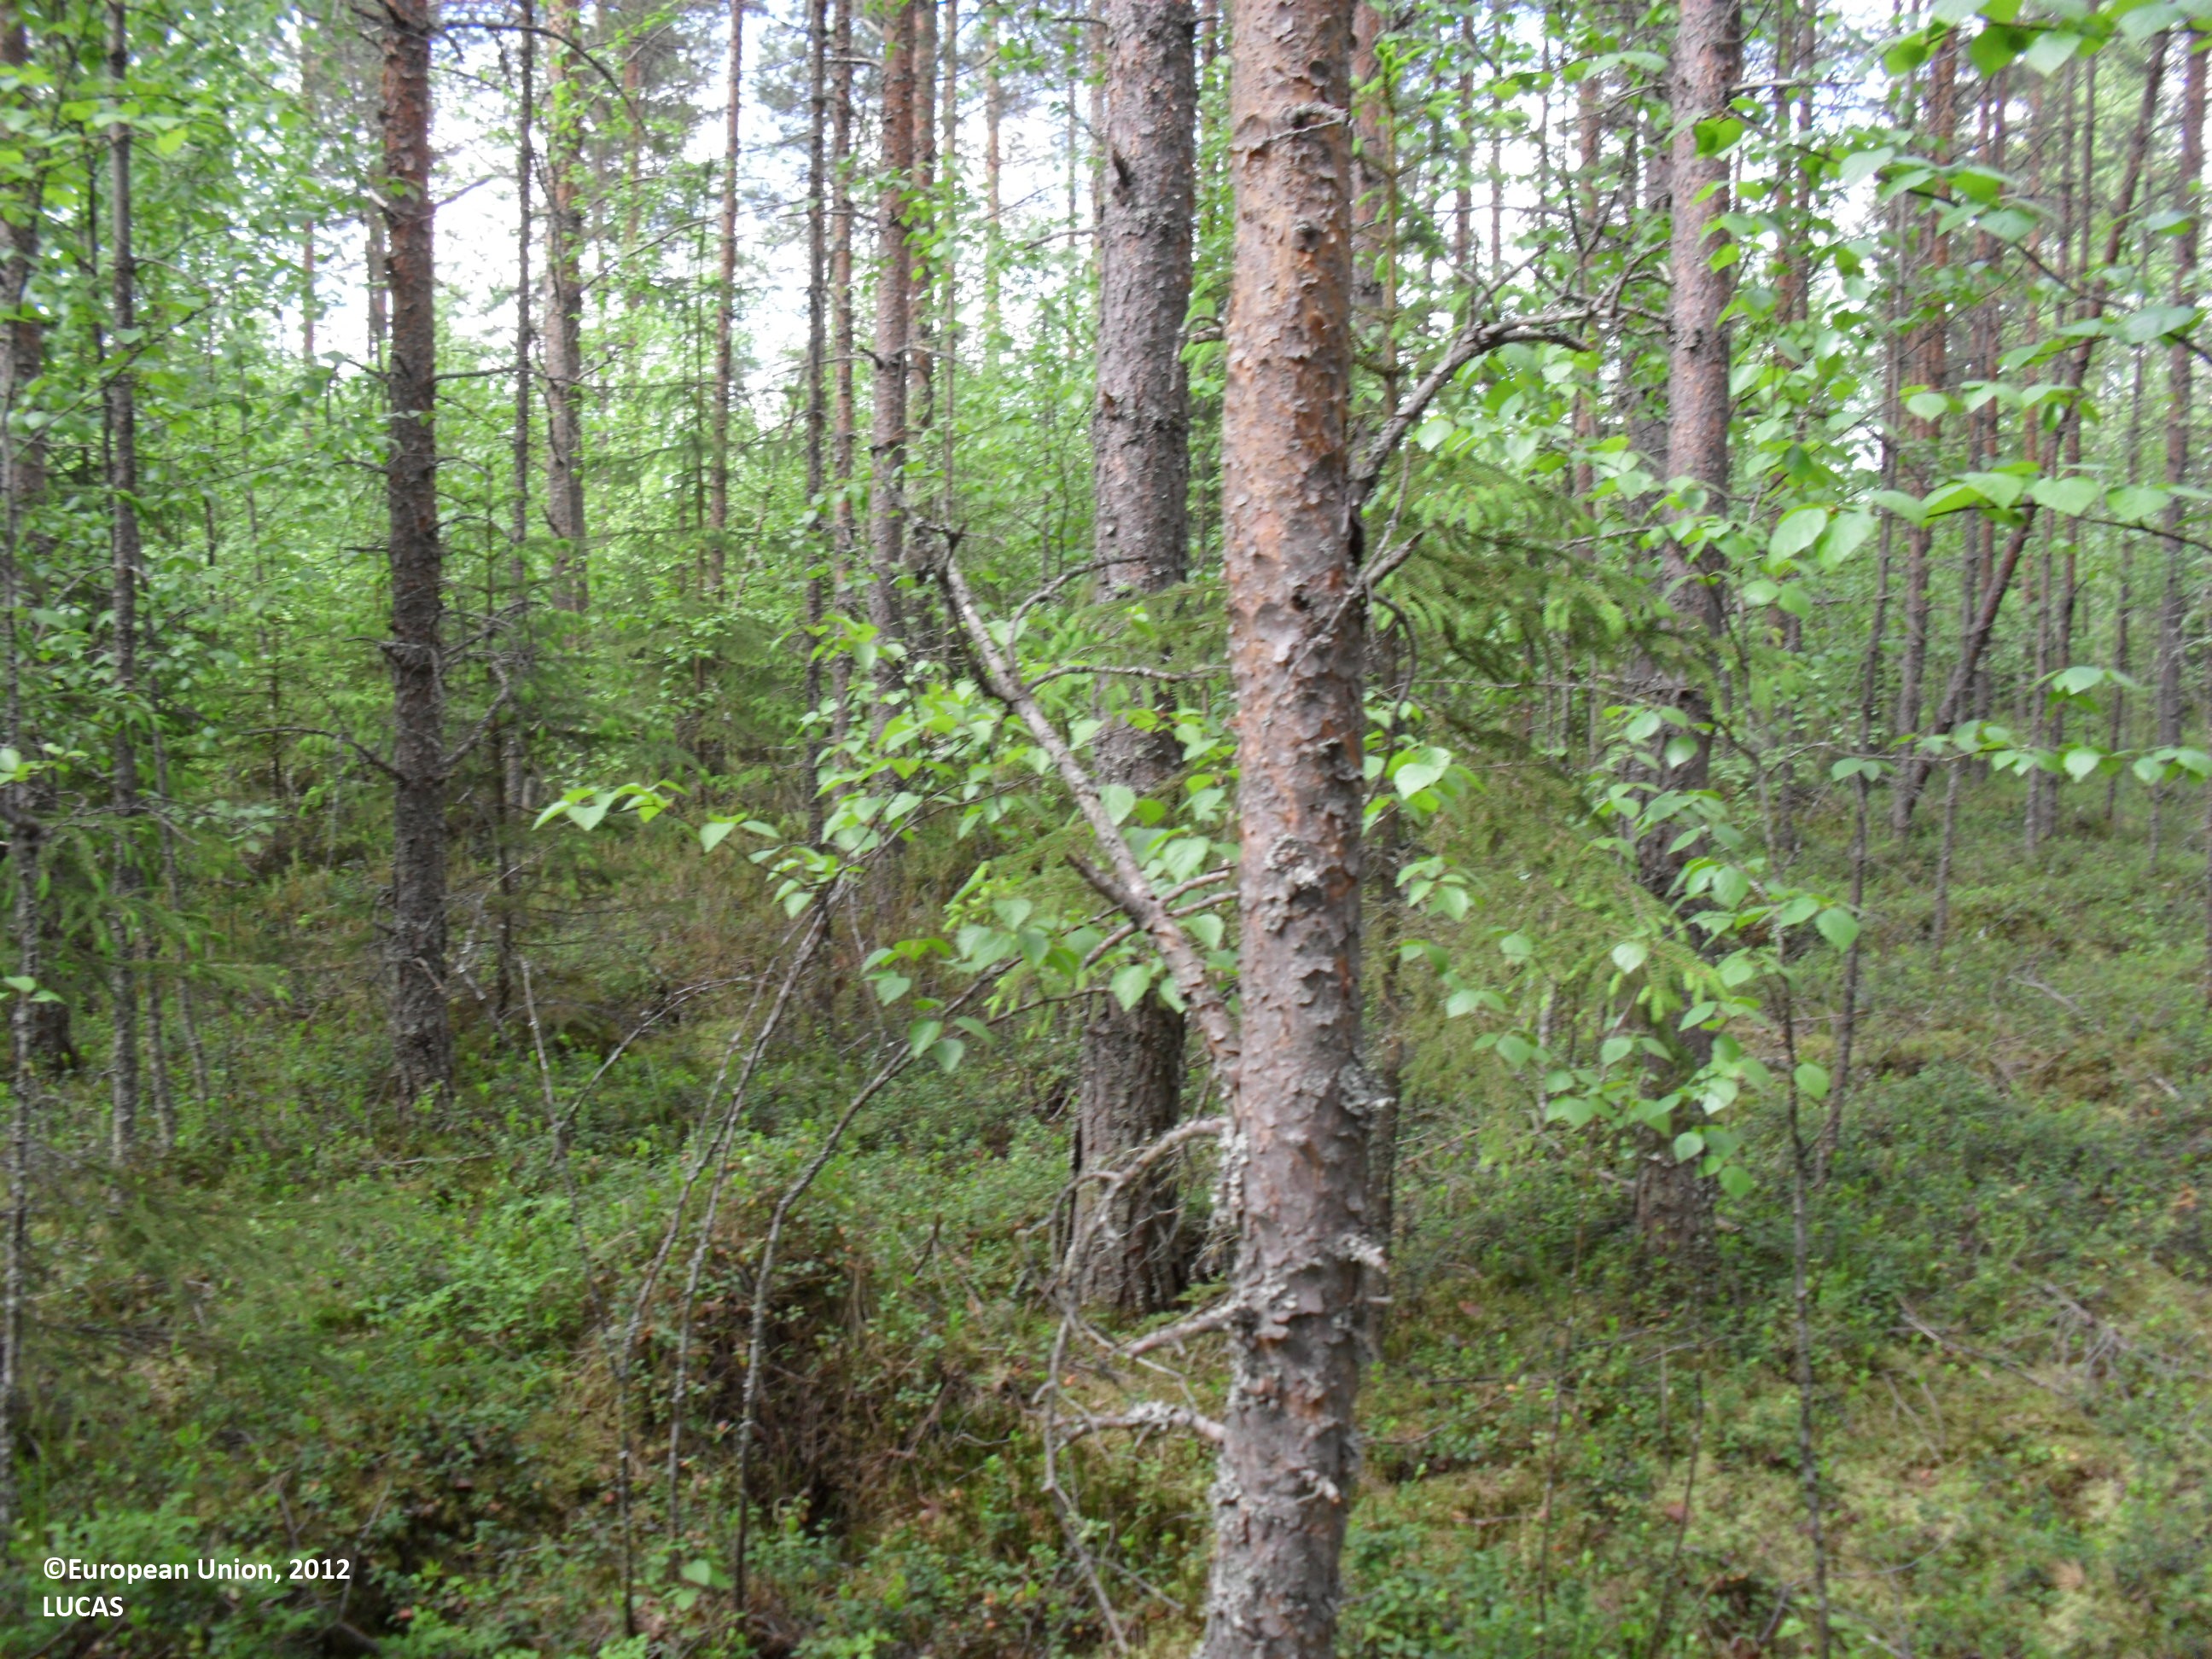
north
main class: Woodland
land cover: Pine dominated mixed woodland
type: boreal forest
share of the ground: 50 - 75 %
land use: Forestry
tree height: > 5 m
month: June
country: FI
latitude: 62.8850
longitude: 23.4598
